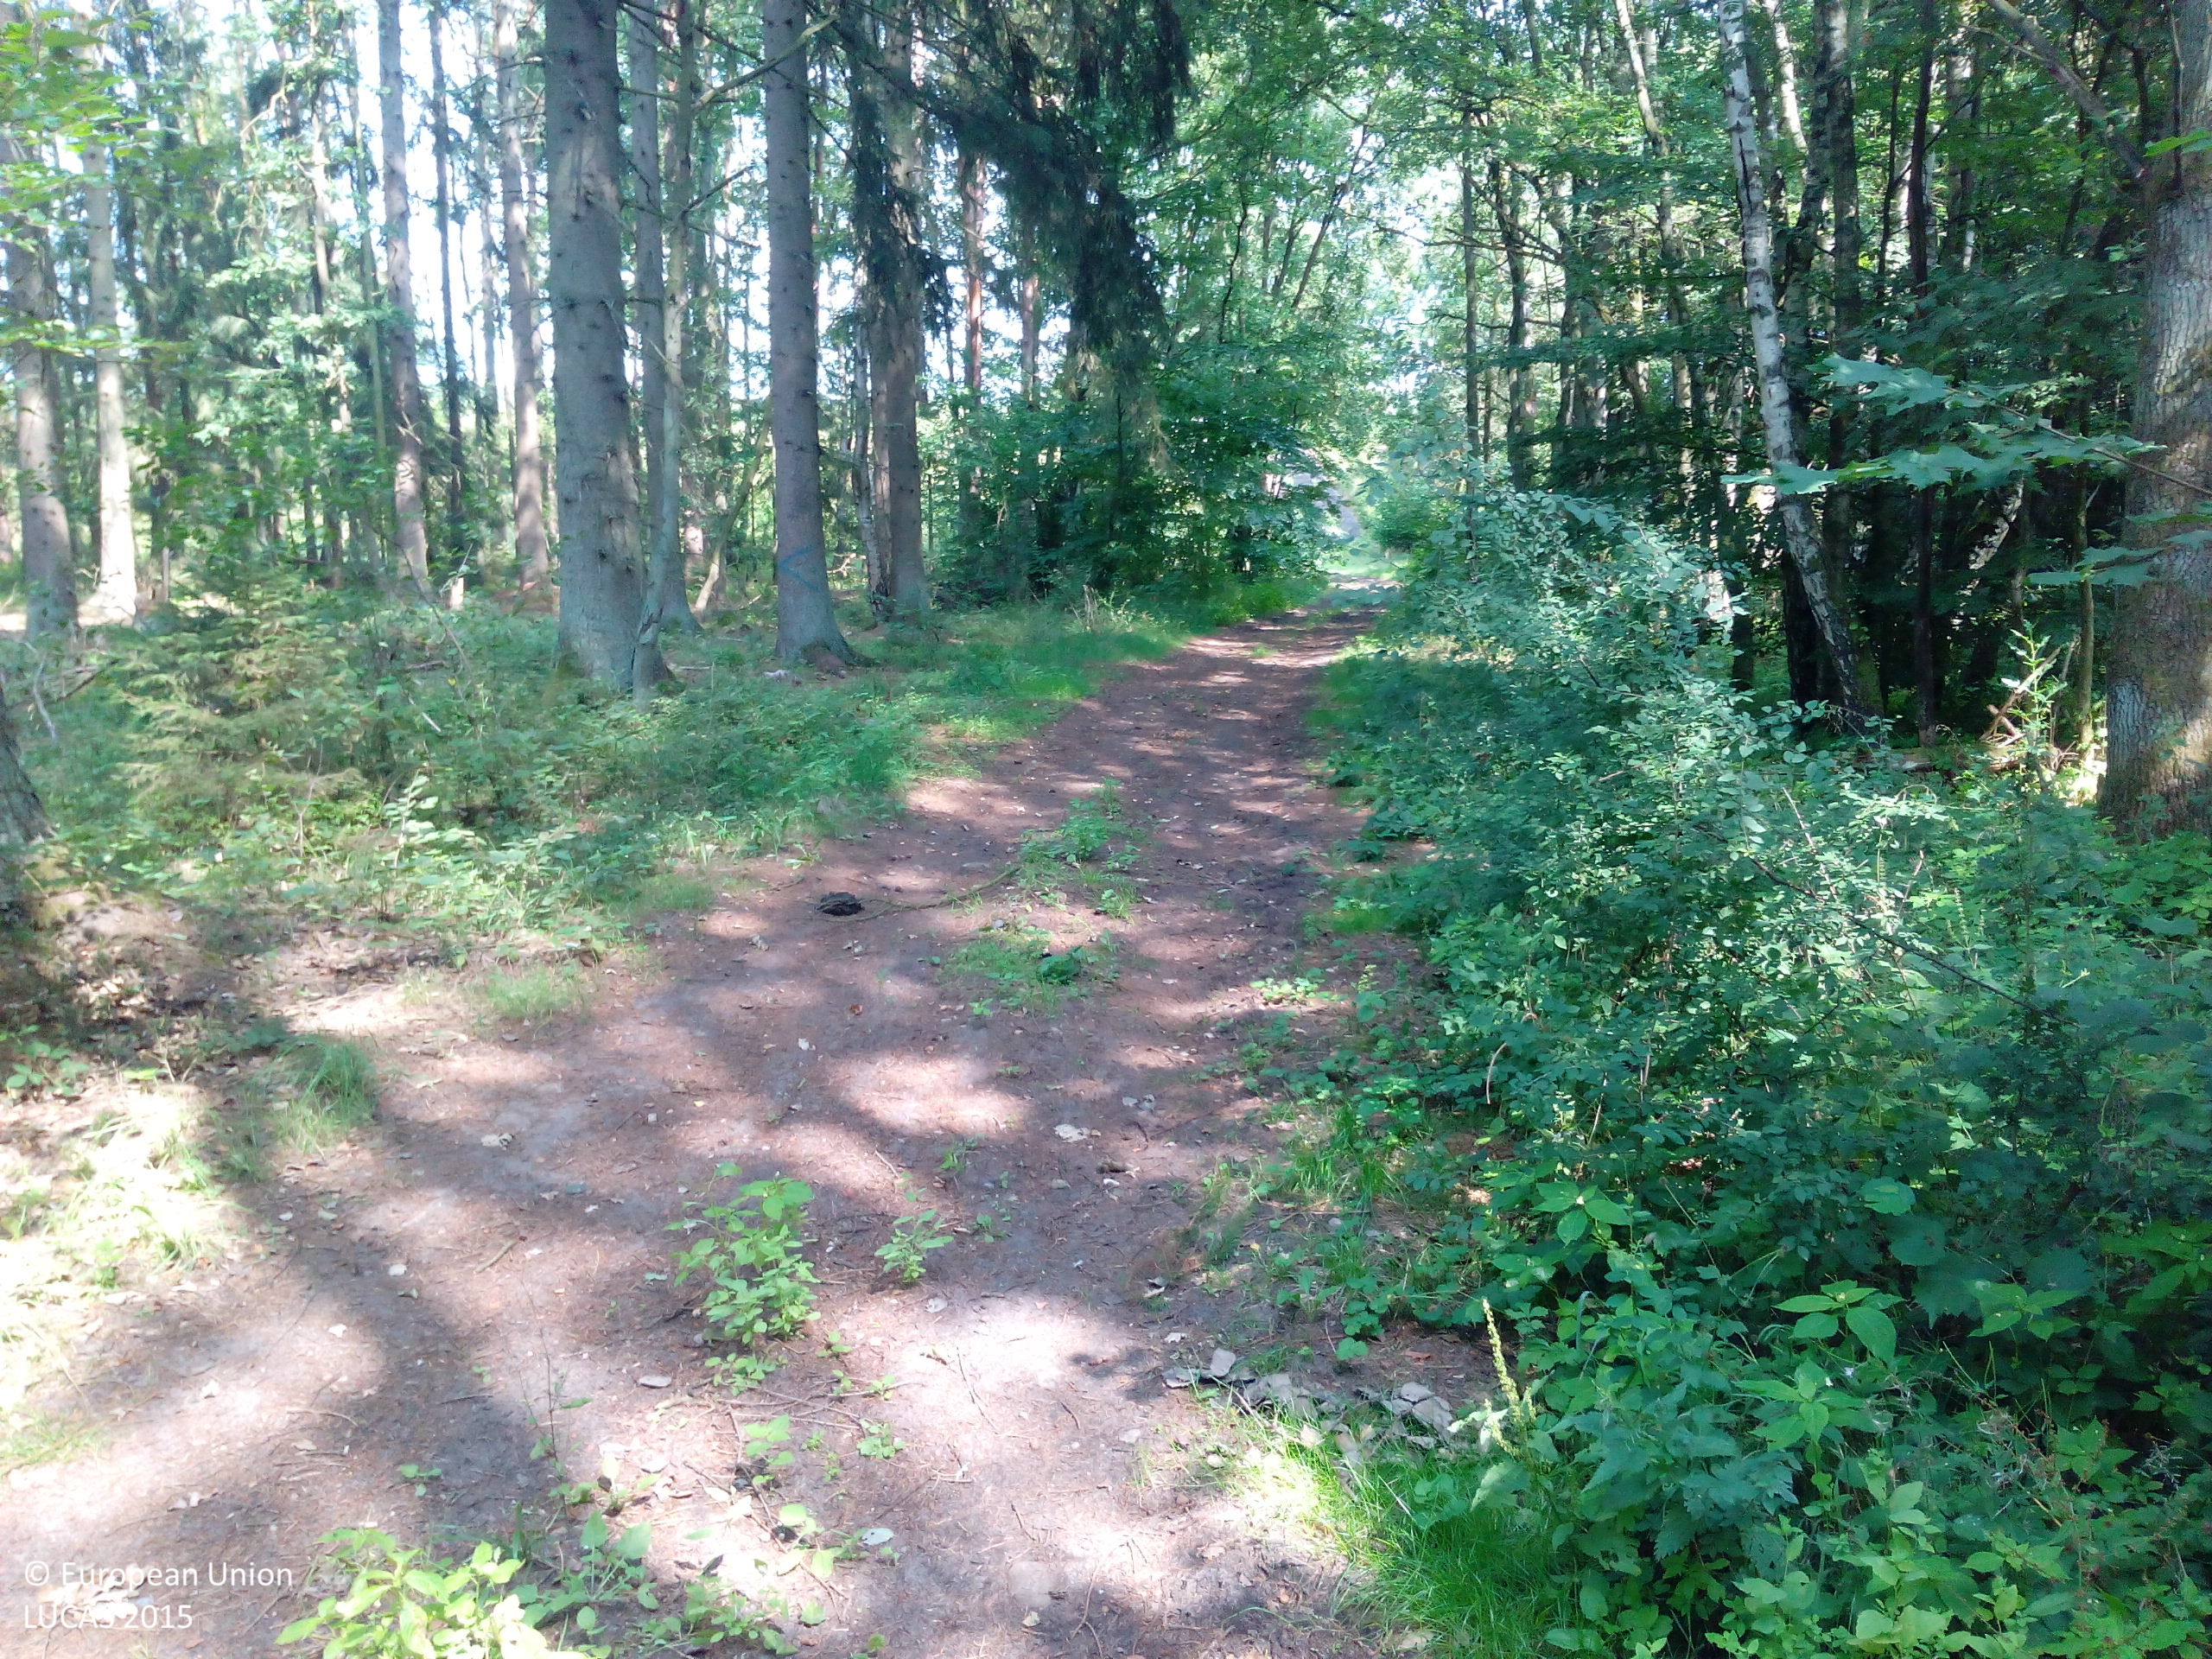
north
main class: Woodland
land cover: Broadleaved woodland
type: beech forest
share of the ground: > 75 %
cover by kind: broadleaved forest trees 100 %
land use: Forestry
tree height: > 5 m
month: August
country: DE
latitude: 53.0061
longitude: 10.3128
